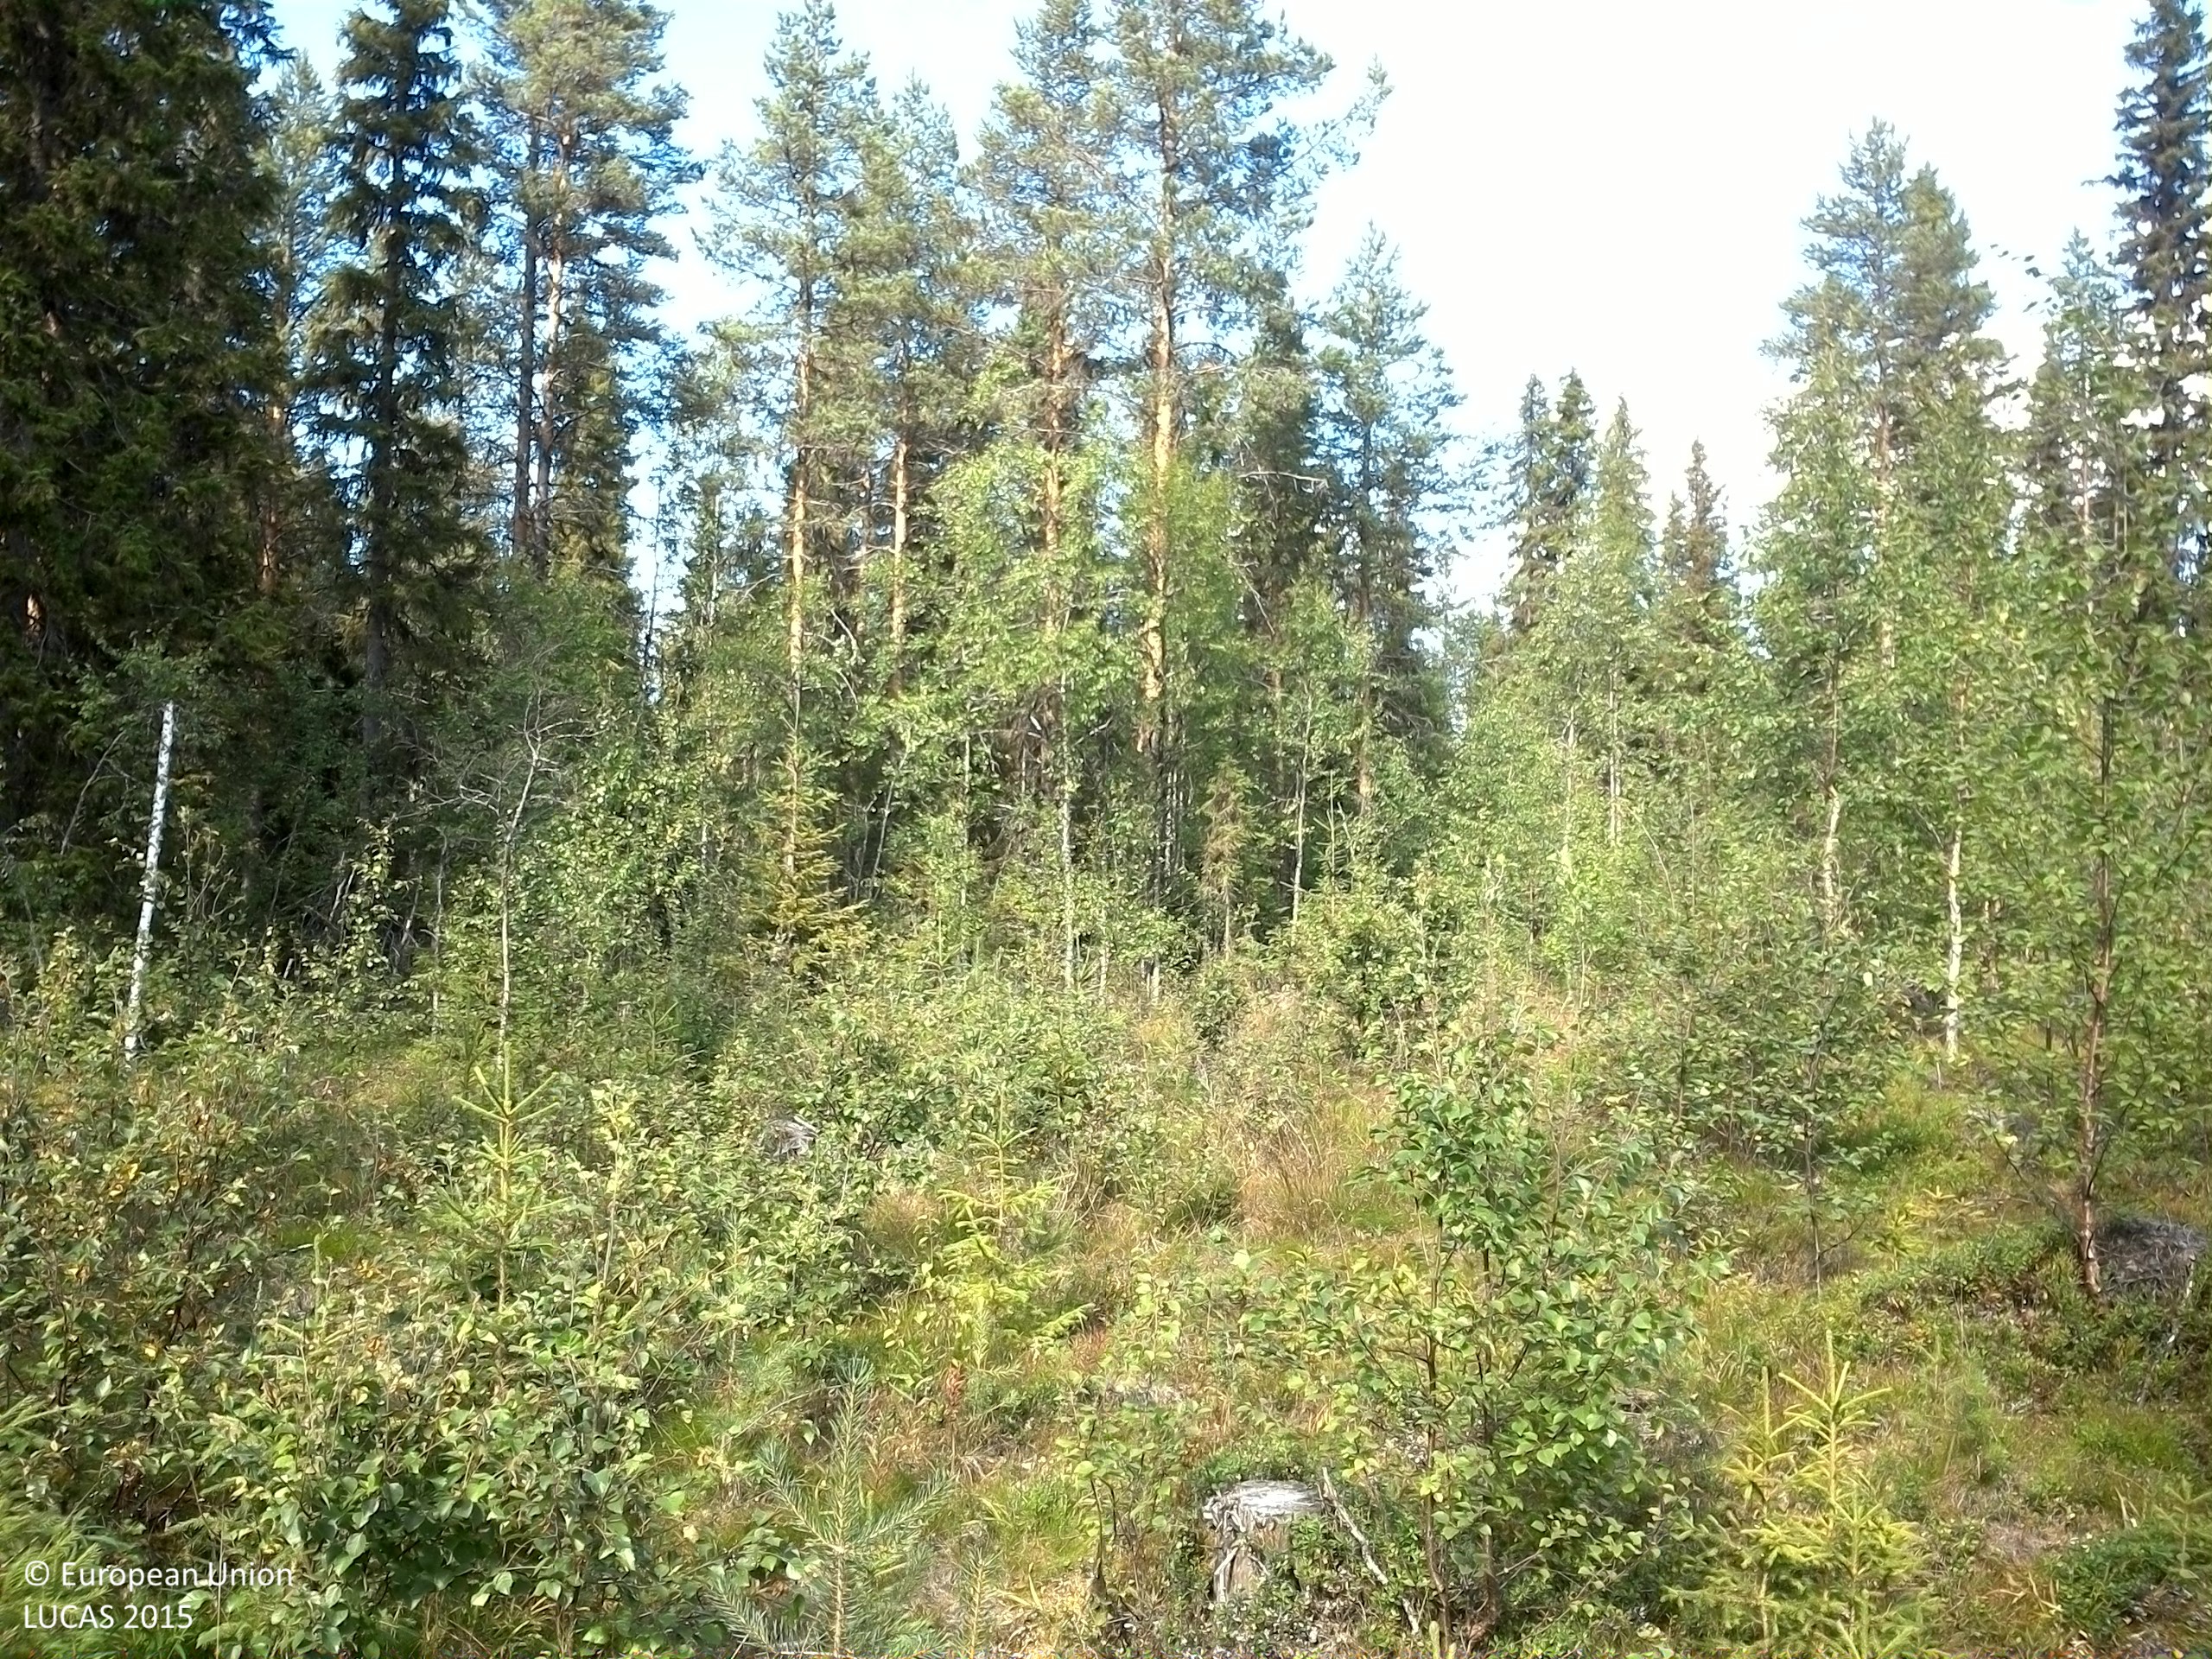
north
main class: Woodland
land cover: Spruce dominated mixed woodland
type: boreal forest
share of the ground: 25 - 50 %
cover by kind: shrubs 30 %, coniferous forest trees 25 %, herbaceous plants 25 %, broadleaved forest trees 15 %, lichens and mosses 5 %
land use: Forestry
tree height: < 5 m
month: August
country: SE
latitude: 64.0879
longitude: 17.6205
